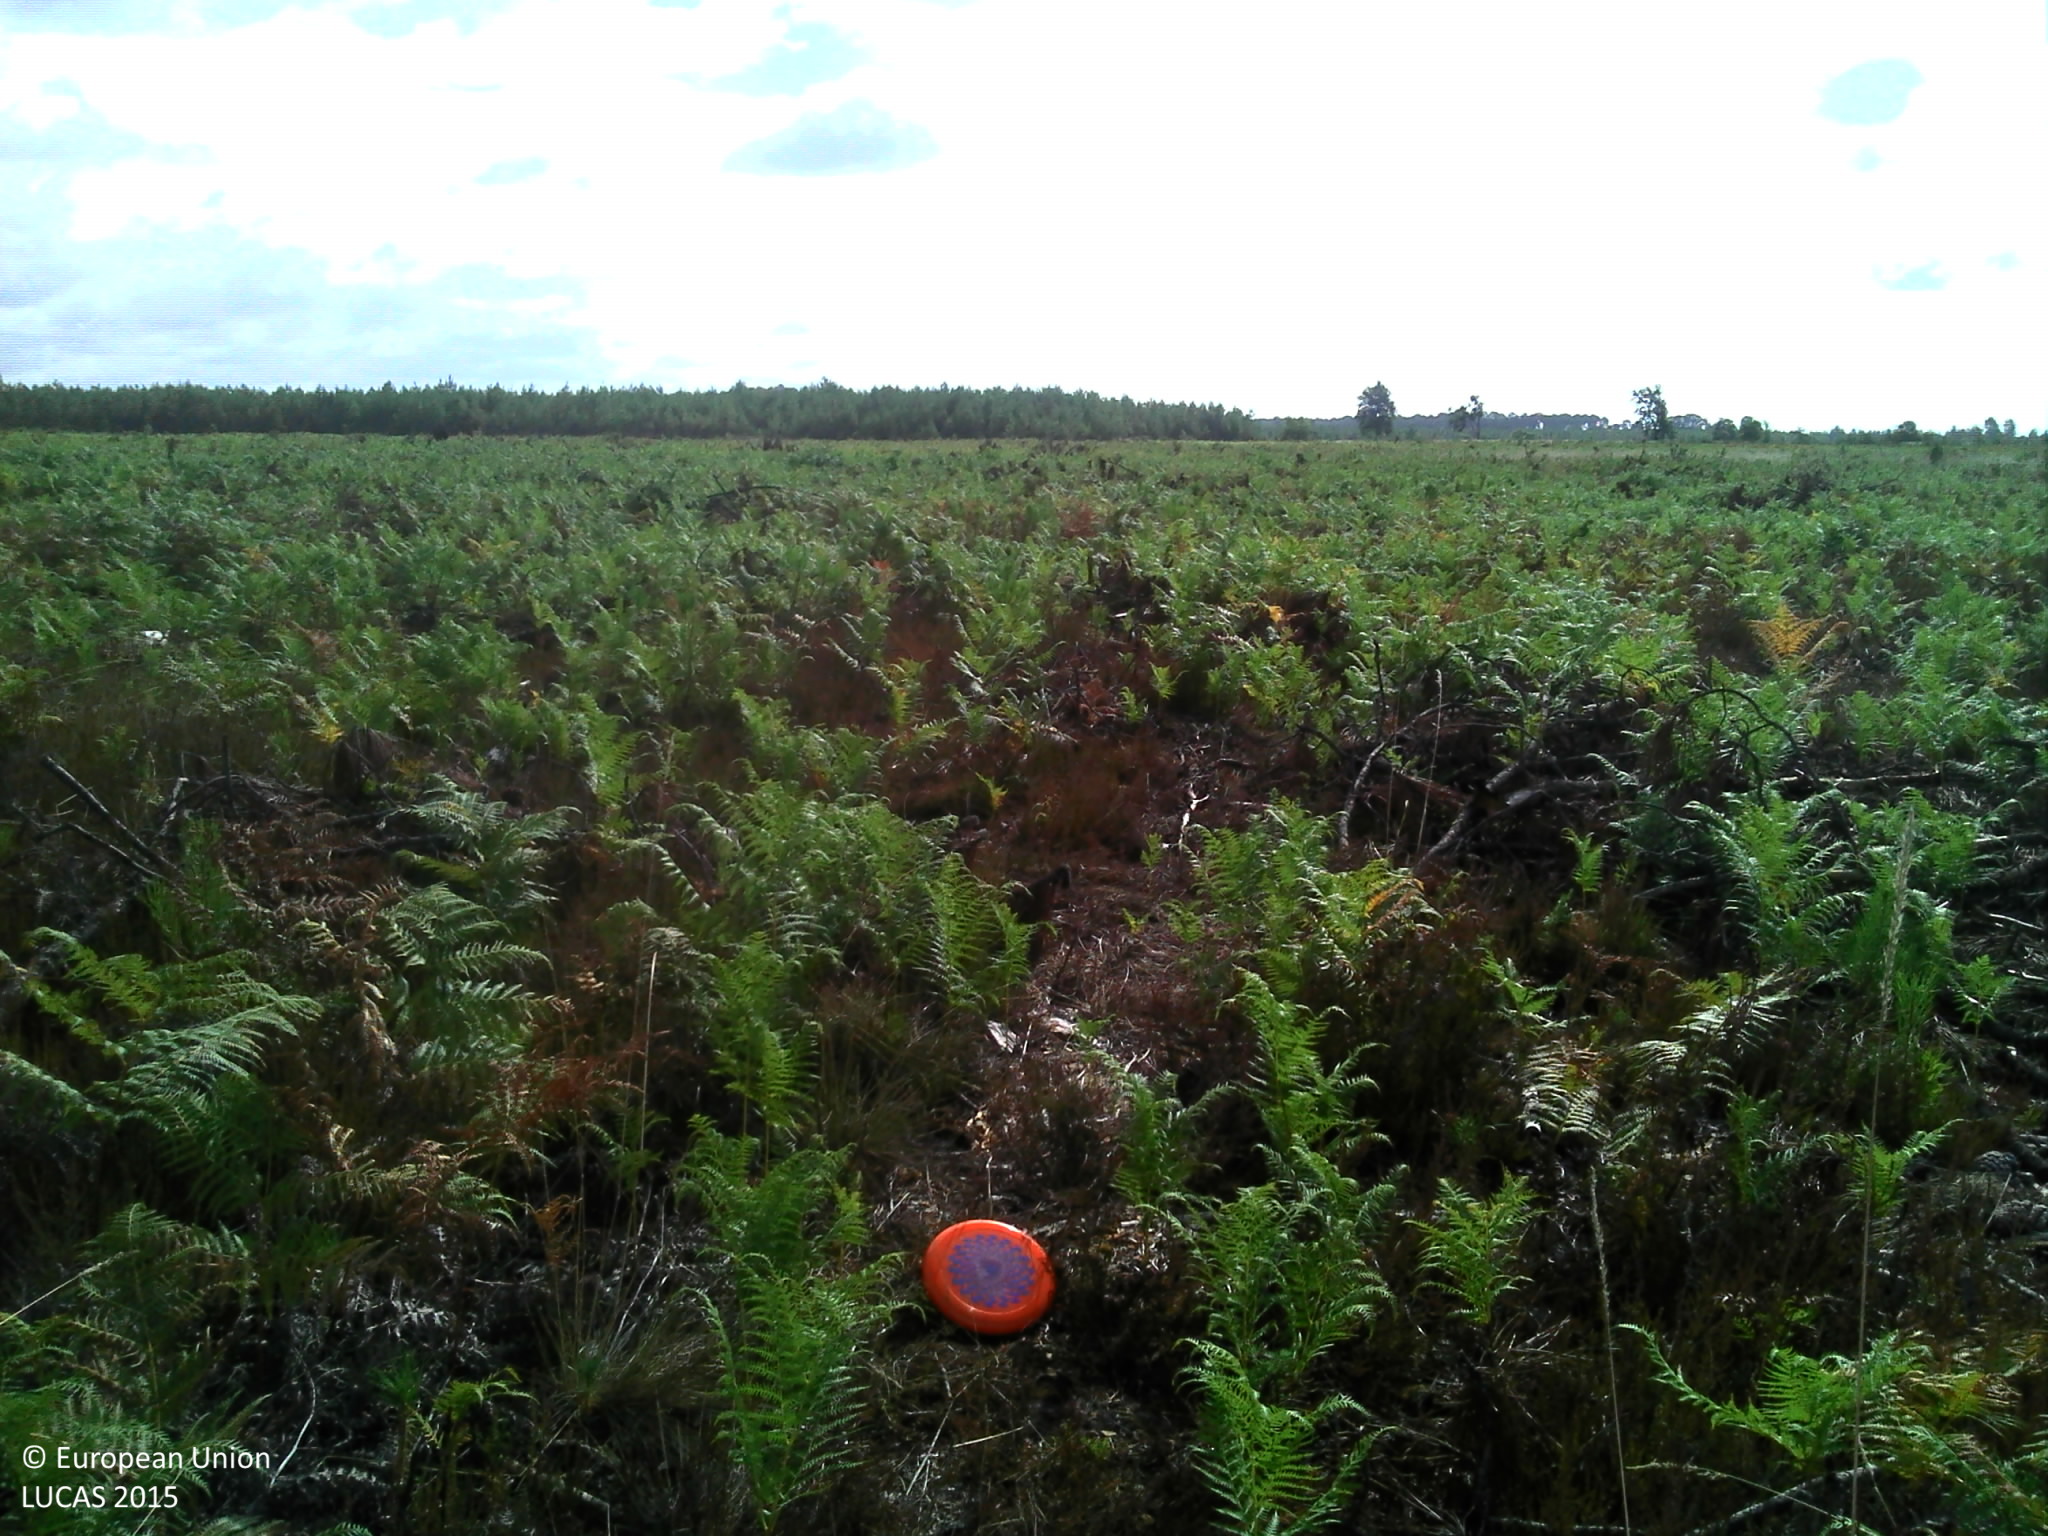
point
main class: Grassland
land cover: Spontaneously vegetated surfaces
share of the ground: > 75 %
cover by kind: herbaceous plants 95 %, shrubs 5 %
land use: Forestry
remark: Clear cut
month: July
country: FR
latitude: 44.1114
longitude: -1.1519
